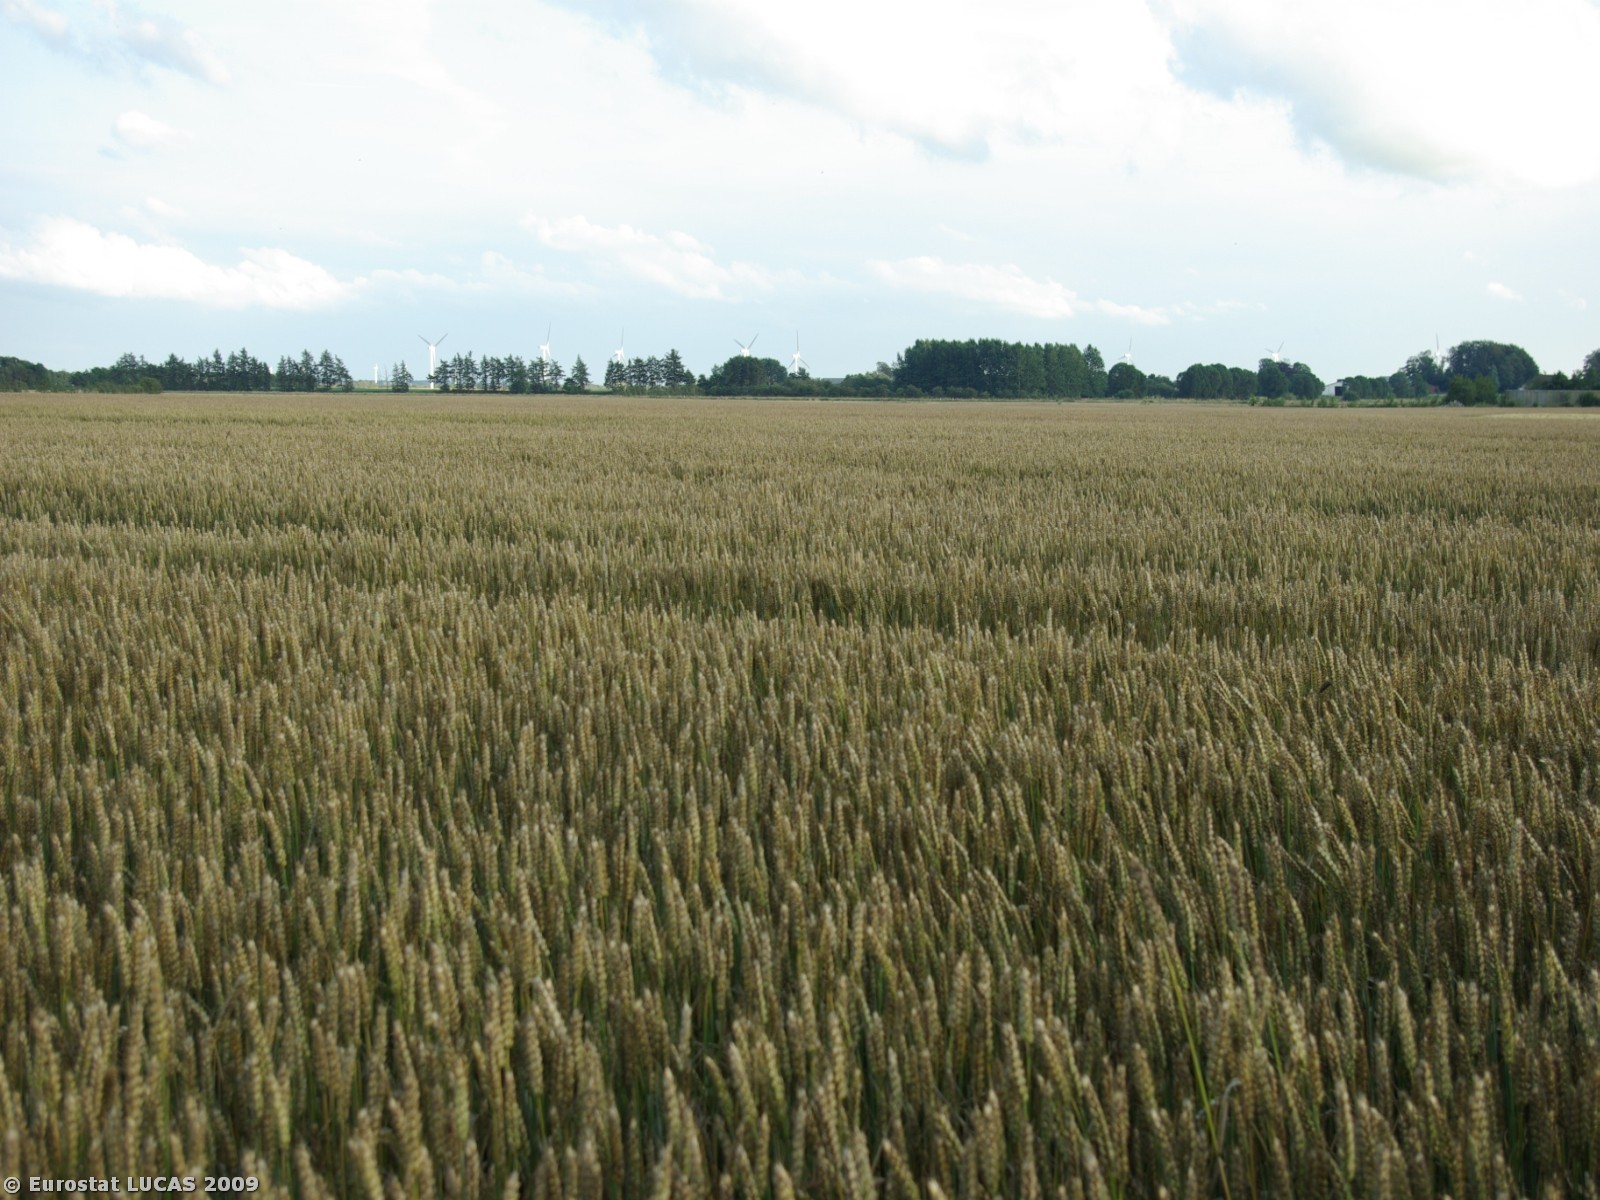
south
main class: Cropland
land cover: Common wheat
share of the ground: > 75 %
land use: Agriculture (excluding fallow land and kitchen gardens)
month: July
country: DK
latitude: 55.1414
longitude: 9.0125
